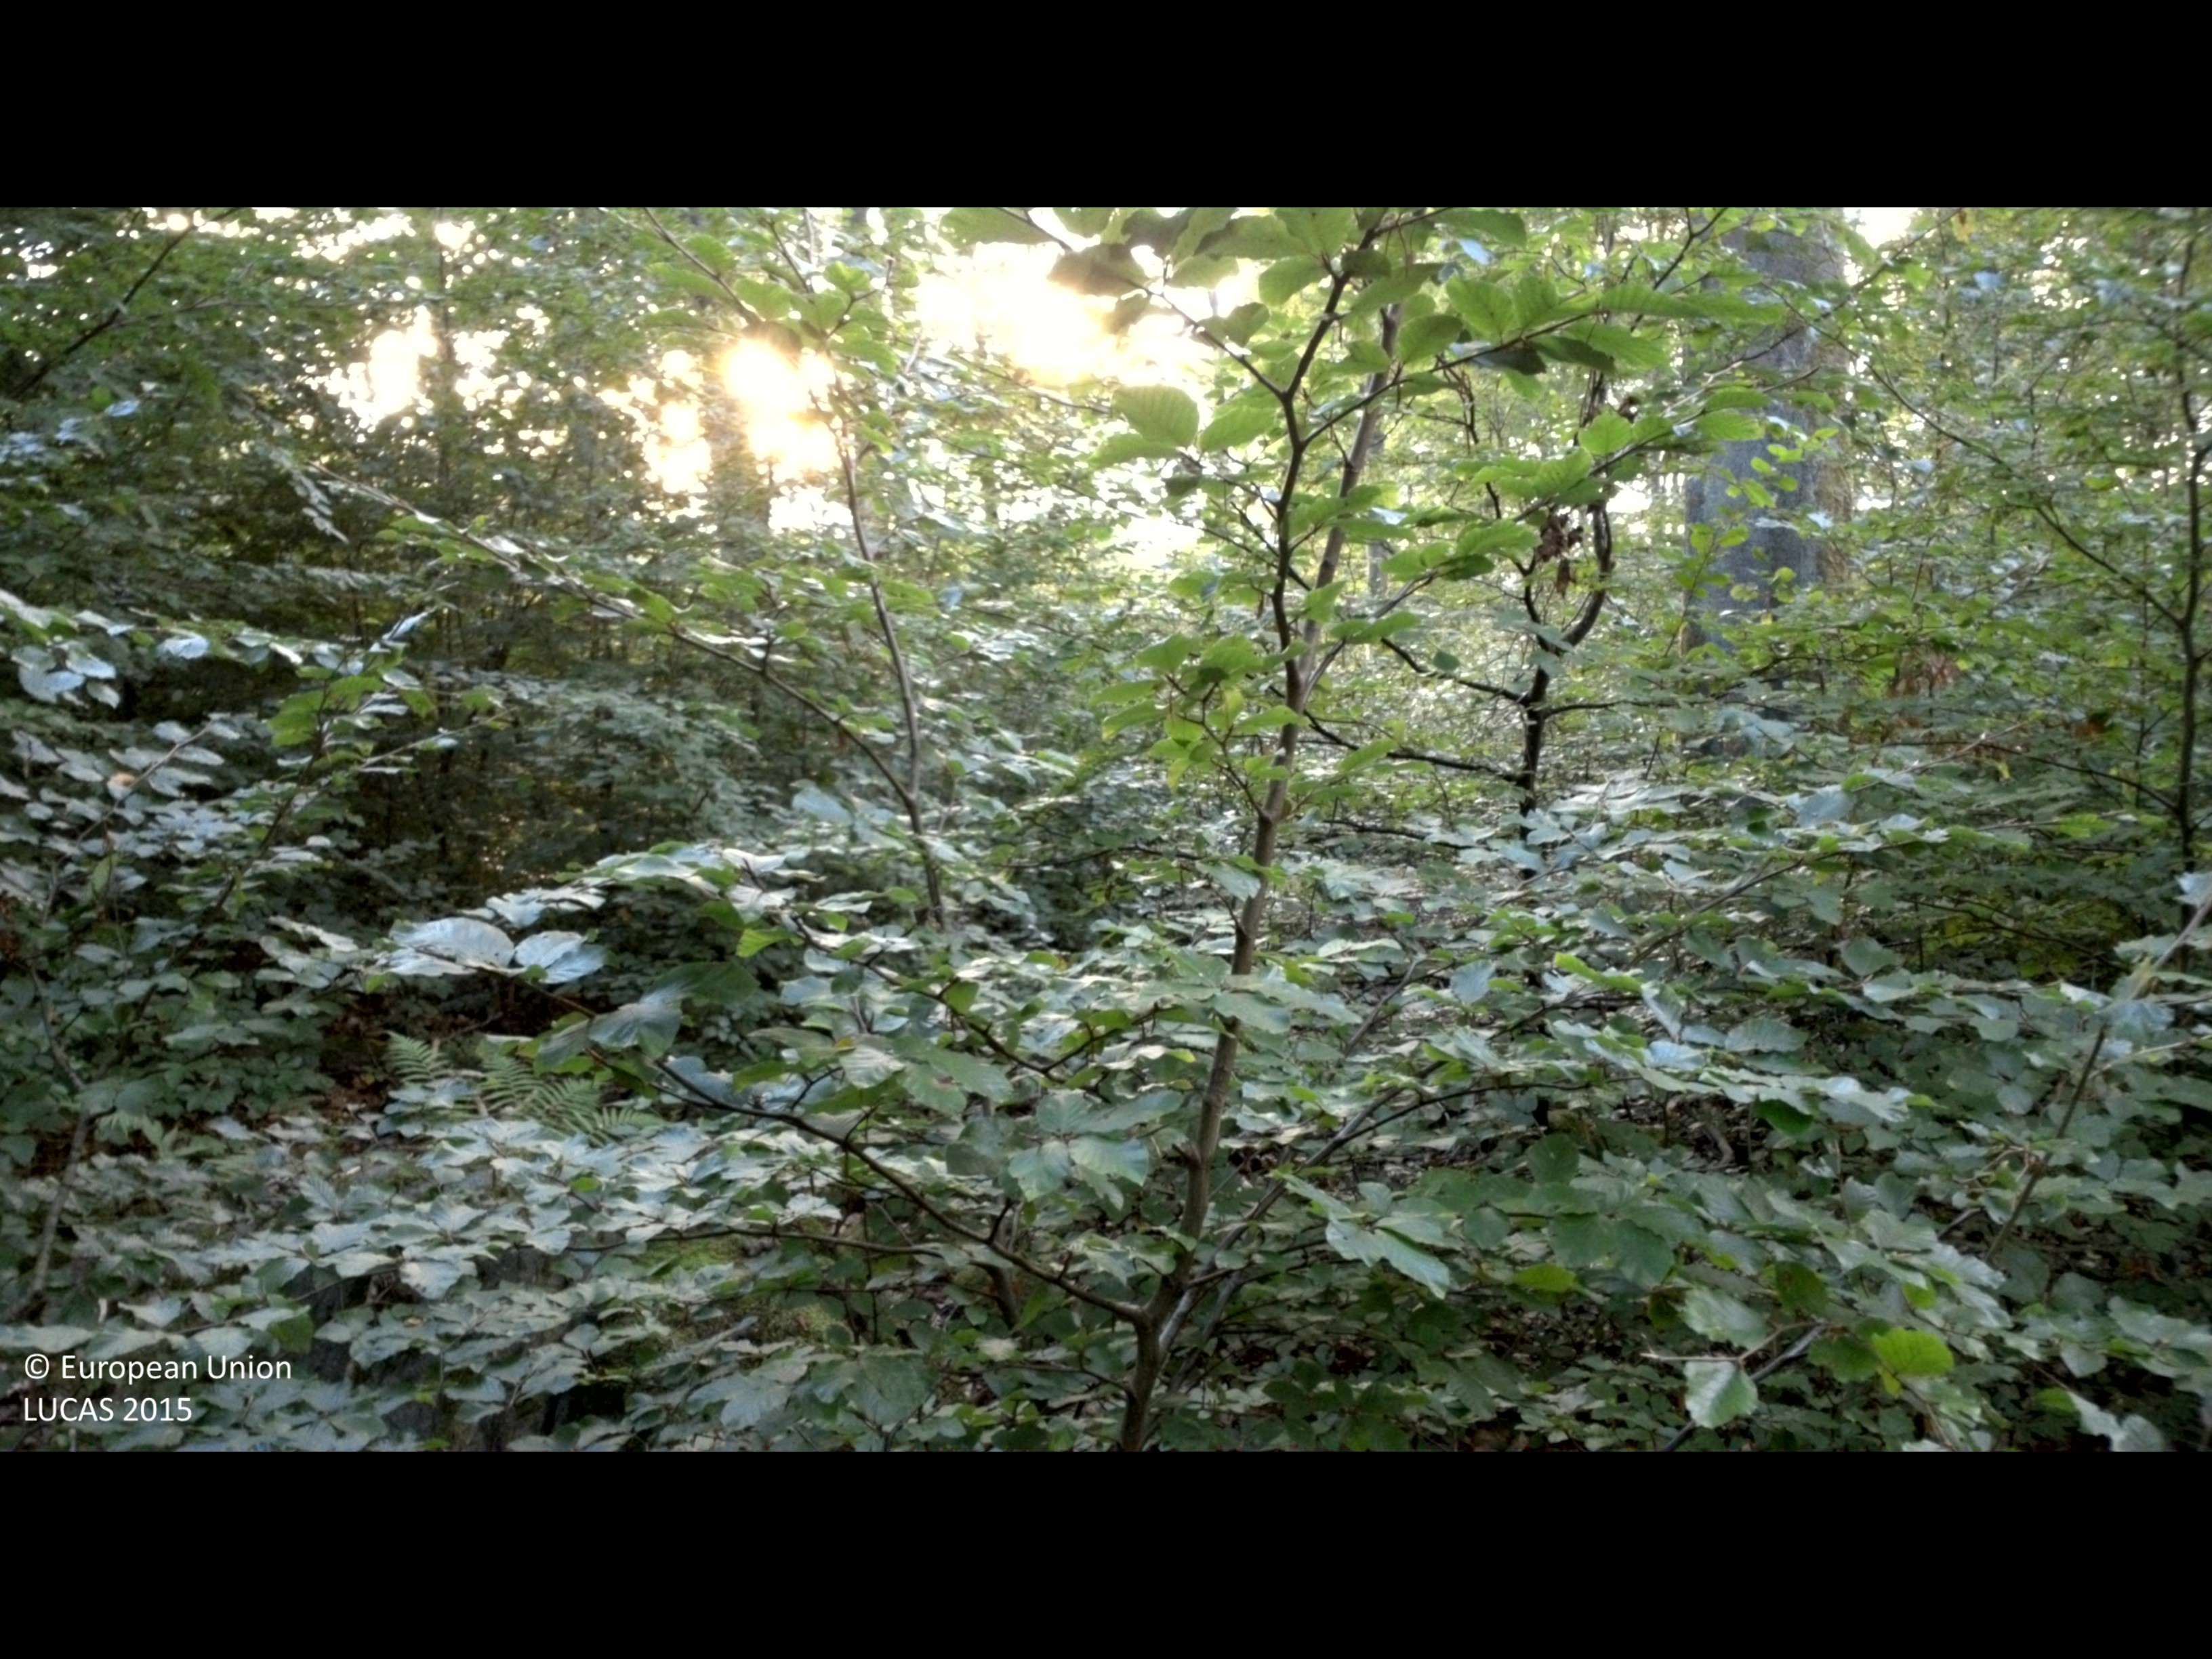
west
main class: Woodland
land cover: Broadleaved woodland
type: beech forest
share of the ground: > 75 %
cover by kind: broadleaved forest trees 80 %, herbaceous plants 5 %, lichens and mosses 5 %
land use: Forestry
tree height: > 5 m
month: September
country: SE
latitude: 56.1182
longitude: 14.2279
